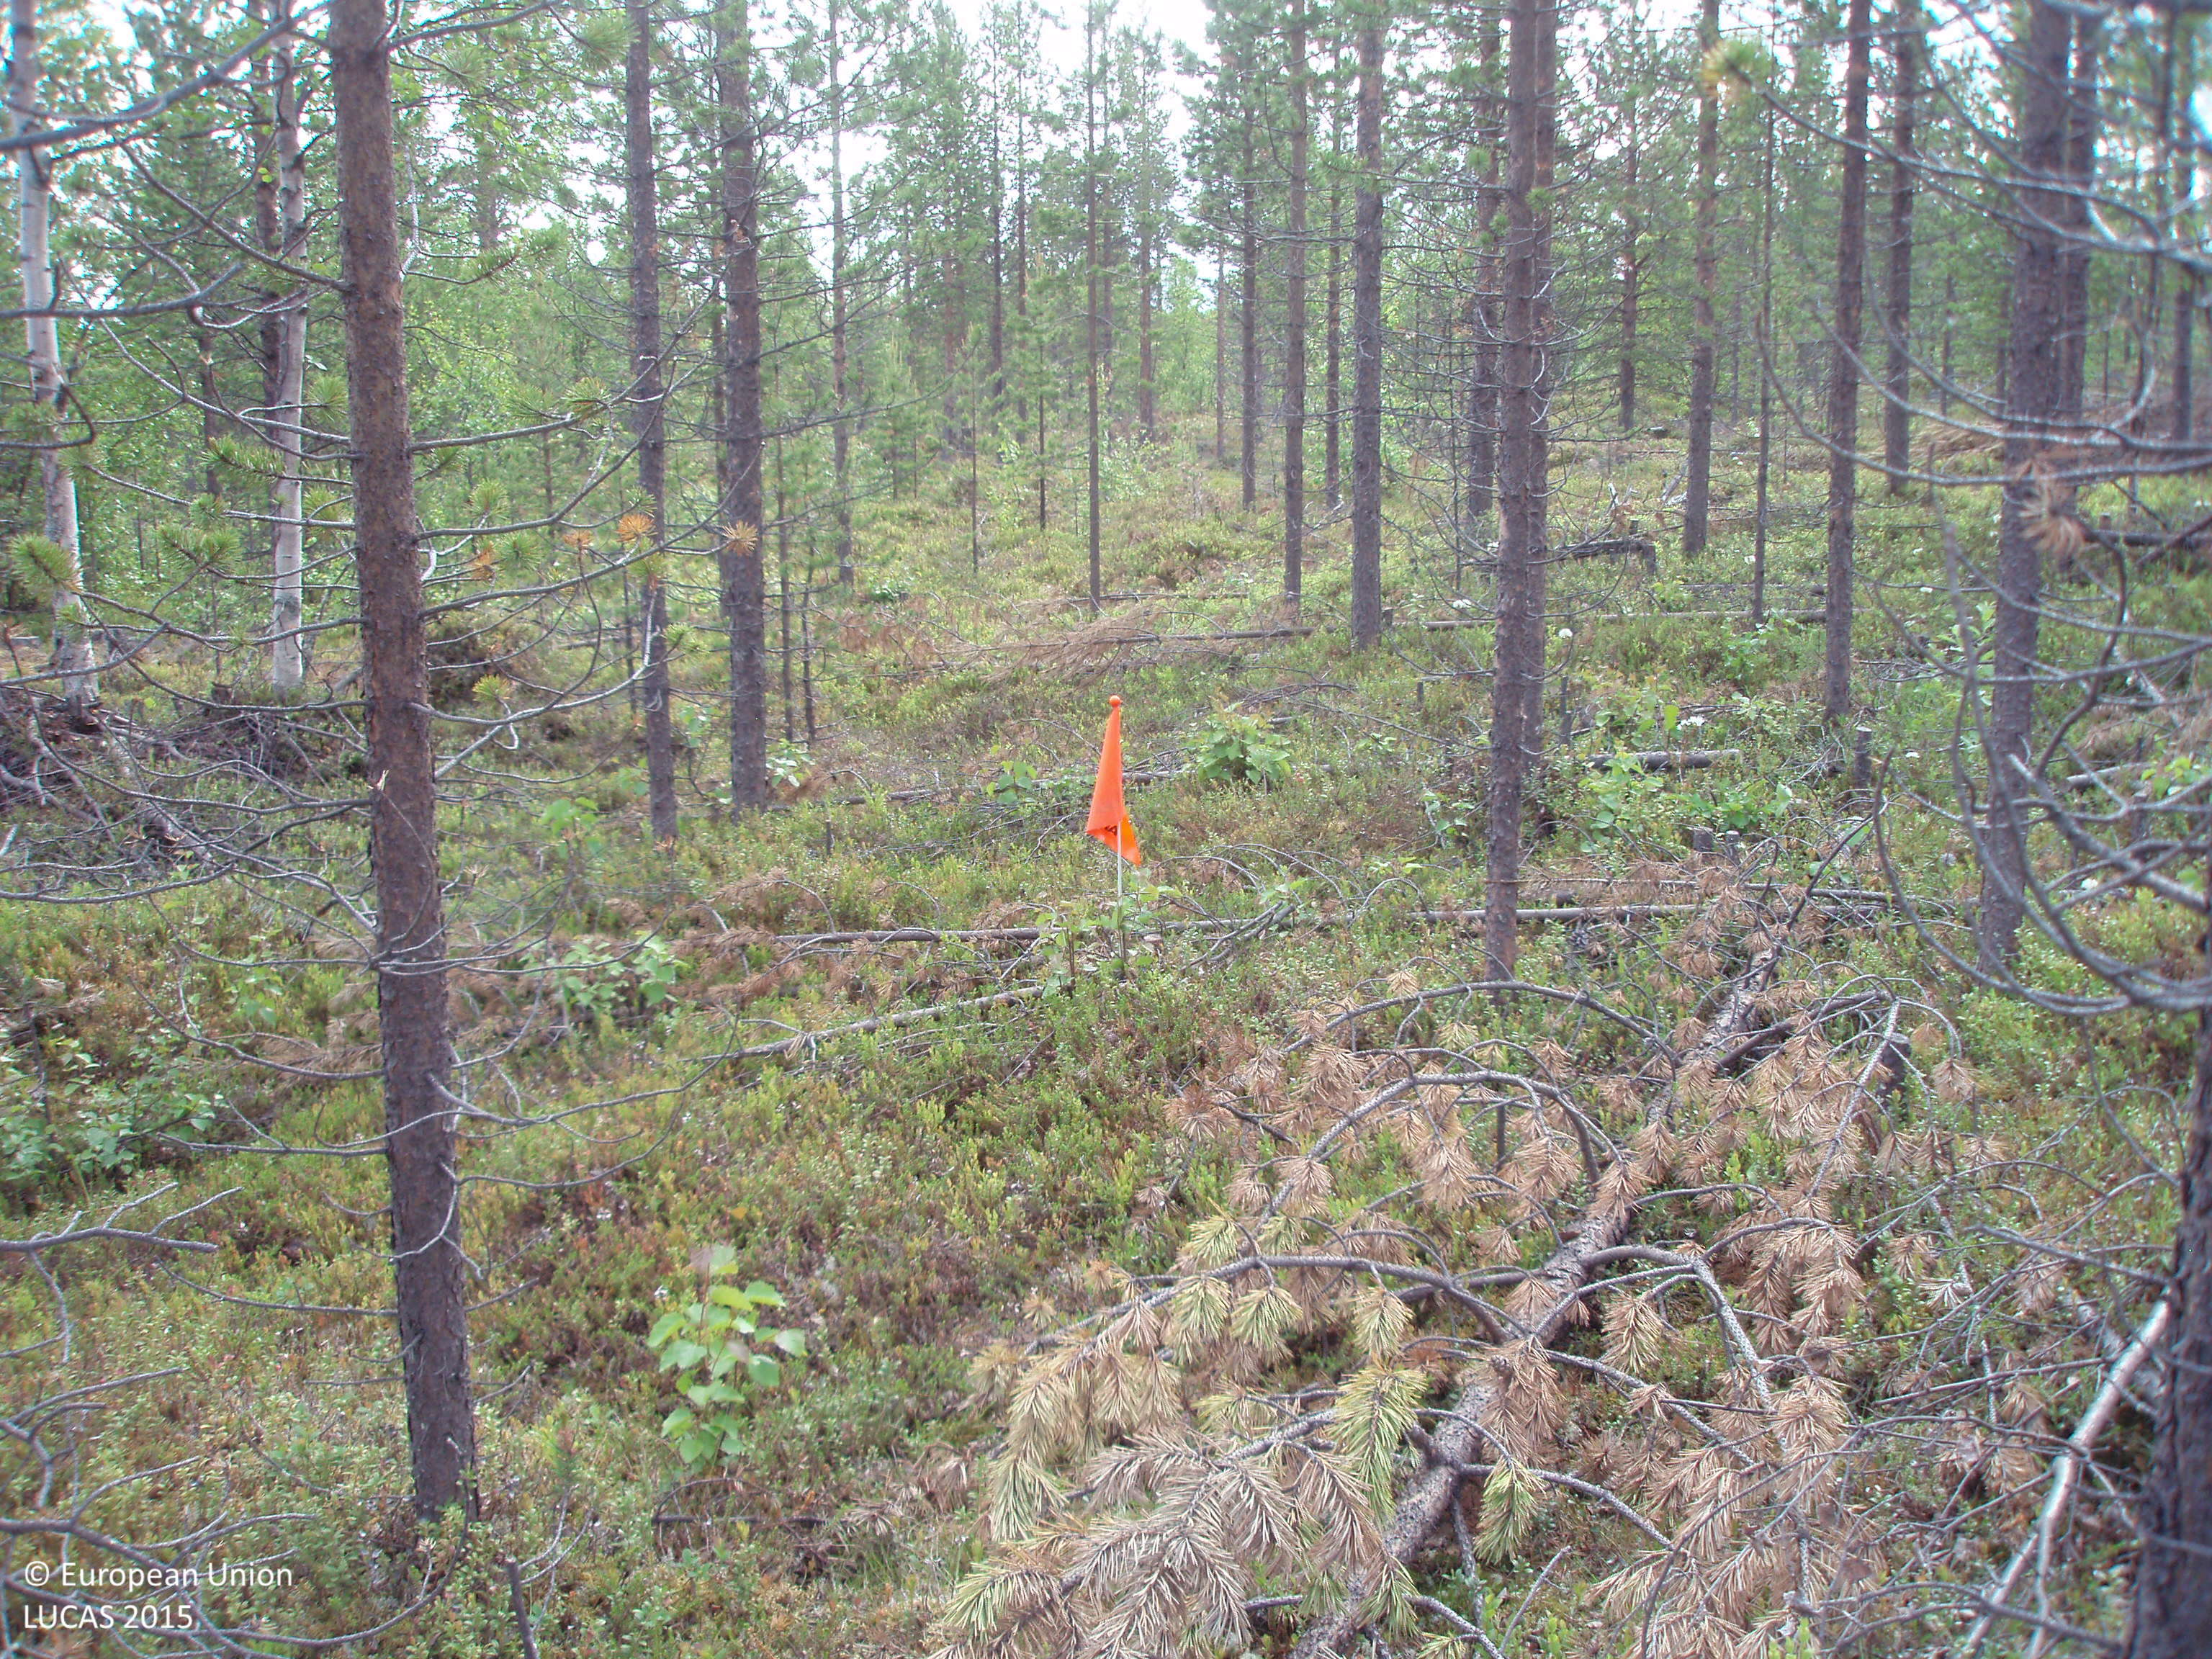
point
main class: Woodland
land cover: Pine dominated mixed woodland
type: boreal forest
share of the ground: 50 - 75 %
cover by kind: coniferous forest trees 40 %, shrubs 40 %, broadleaved forest trees 20 %
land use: Forestry
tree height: > 5 m
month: July
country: FI
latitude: 69.0719
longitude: 27.2978
